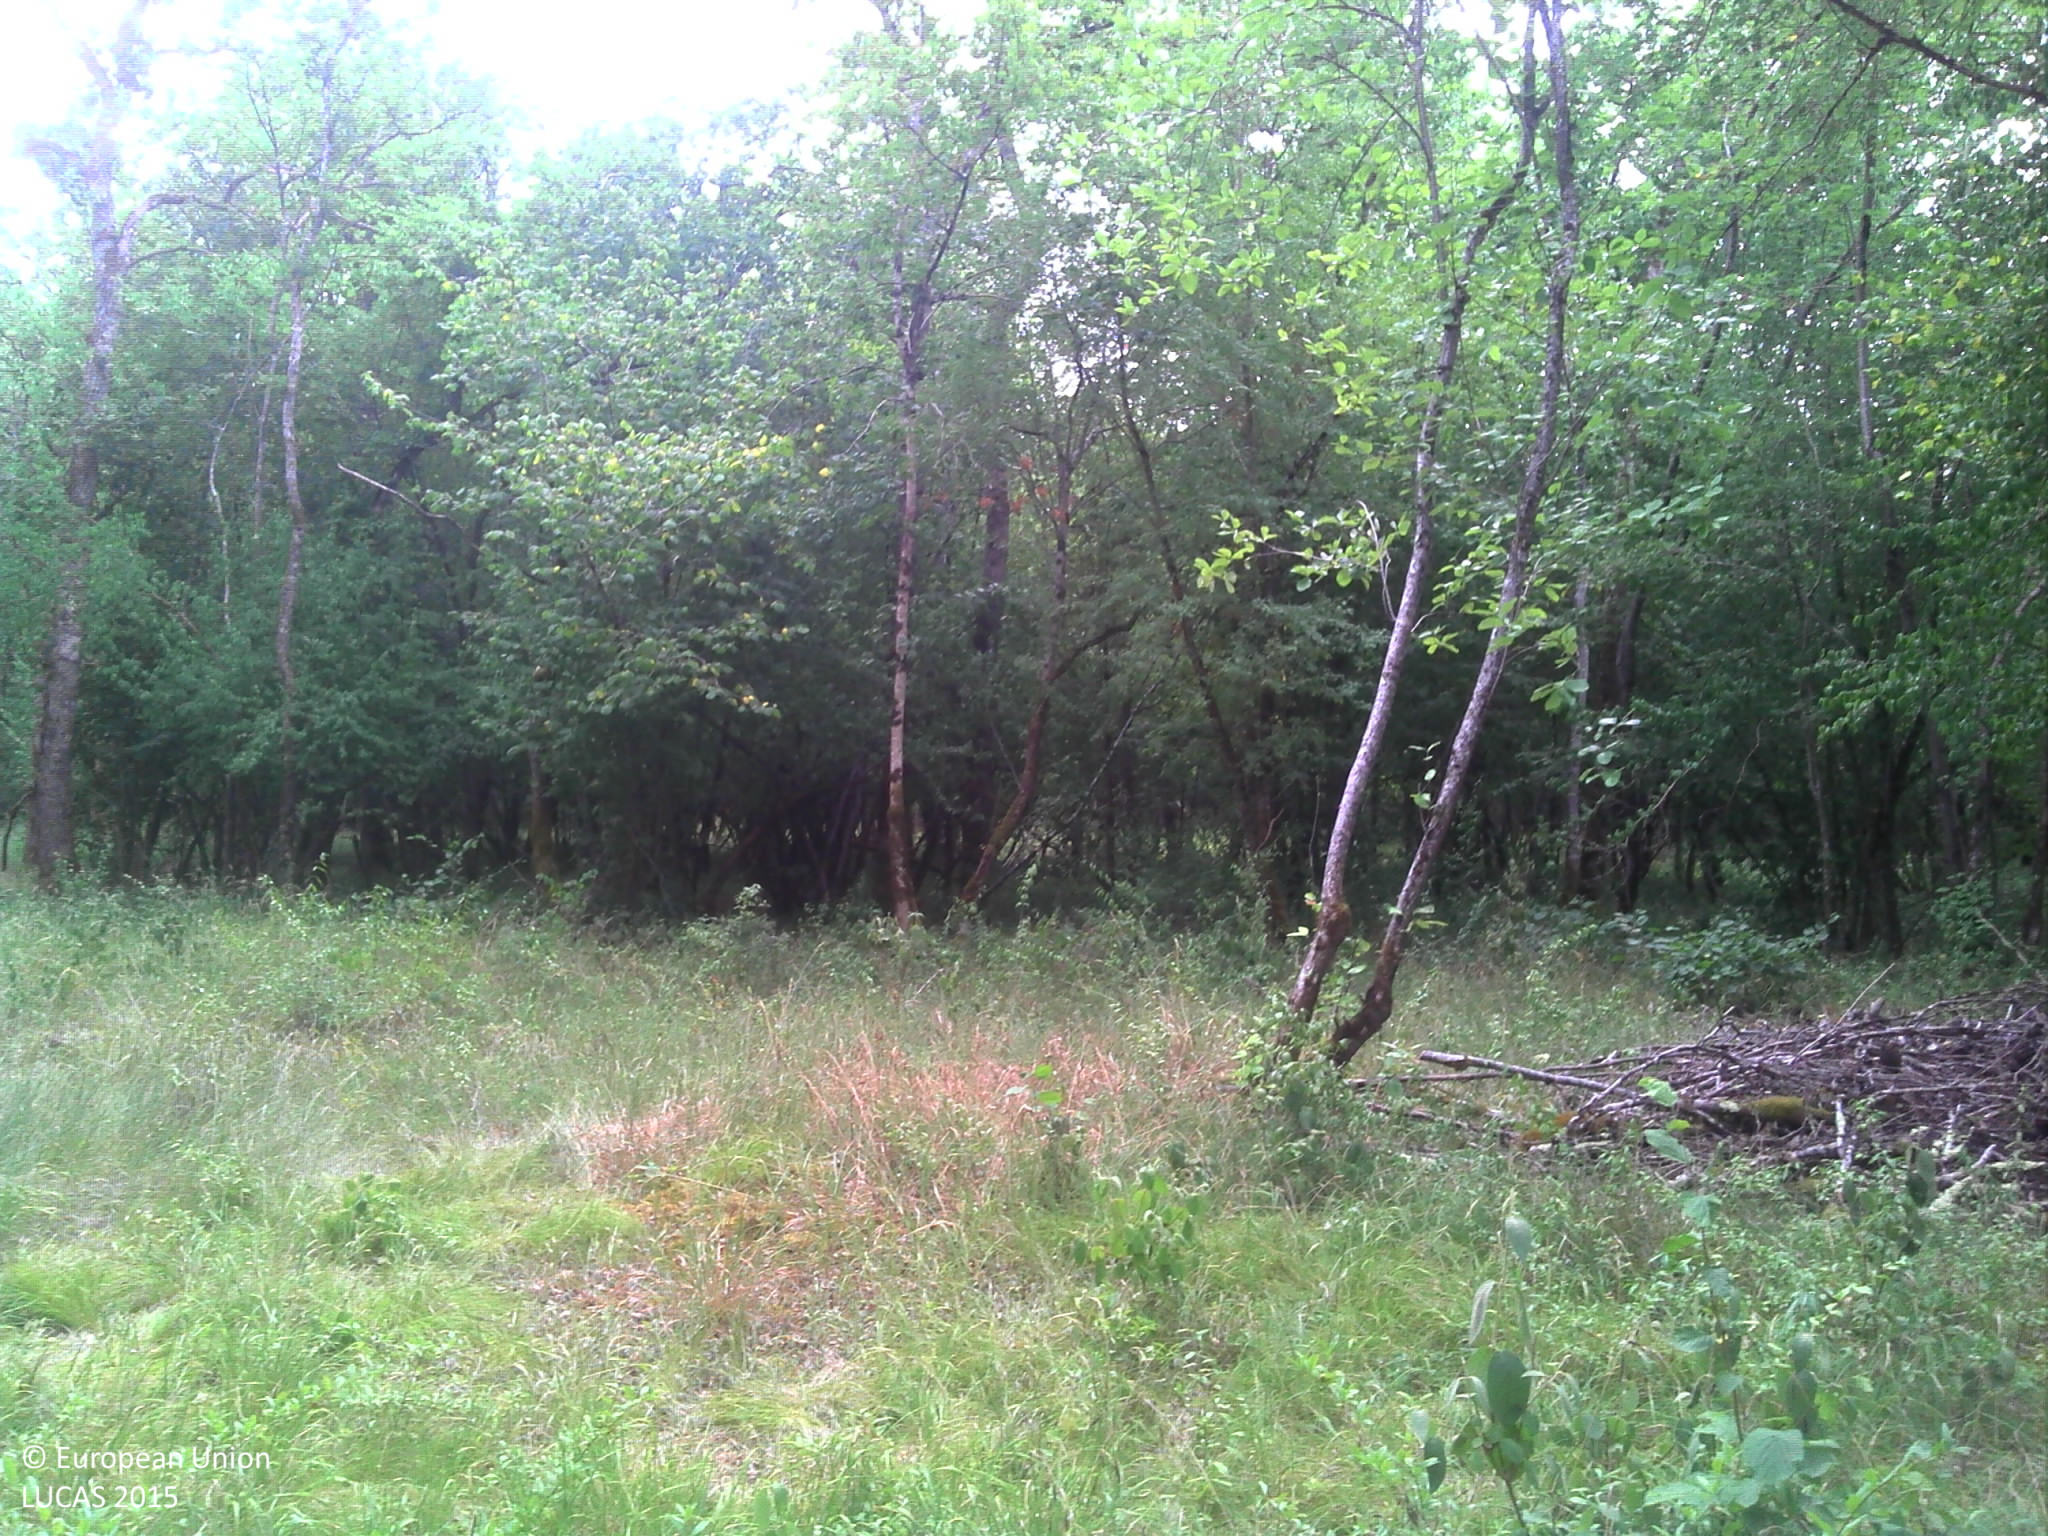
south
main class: Woodland
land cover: Broadleaved woodland
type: acidophilous oak and oak-birch forest
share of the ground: > 75 %
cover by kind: broadleaved forest trees 60 %, herbaceous plants 20 %, shrubs 10 %, lichens and mosses 10 %
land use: Forestry
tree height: > 5 m
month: July
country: FR
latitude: 47.9457
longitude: 4.9517
